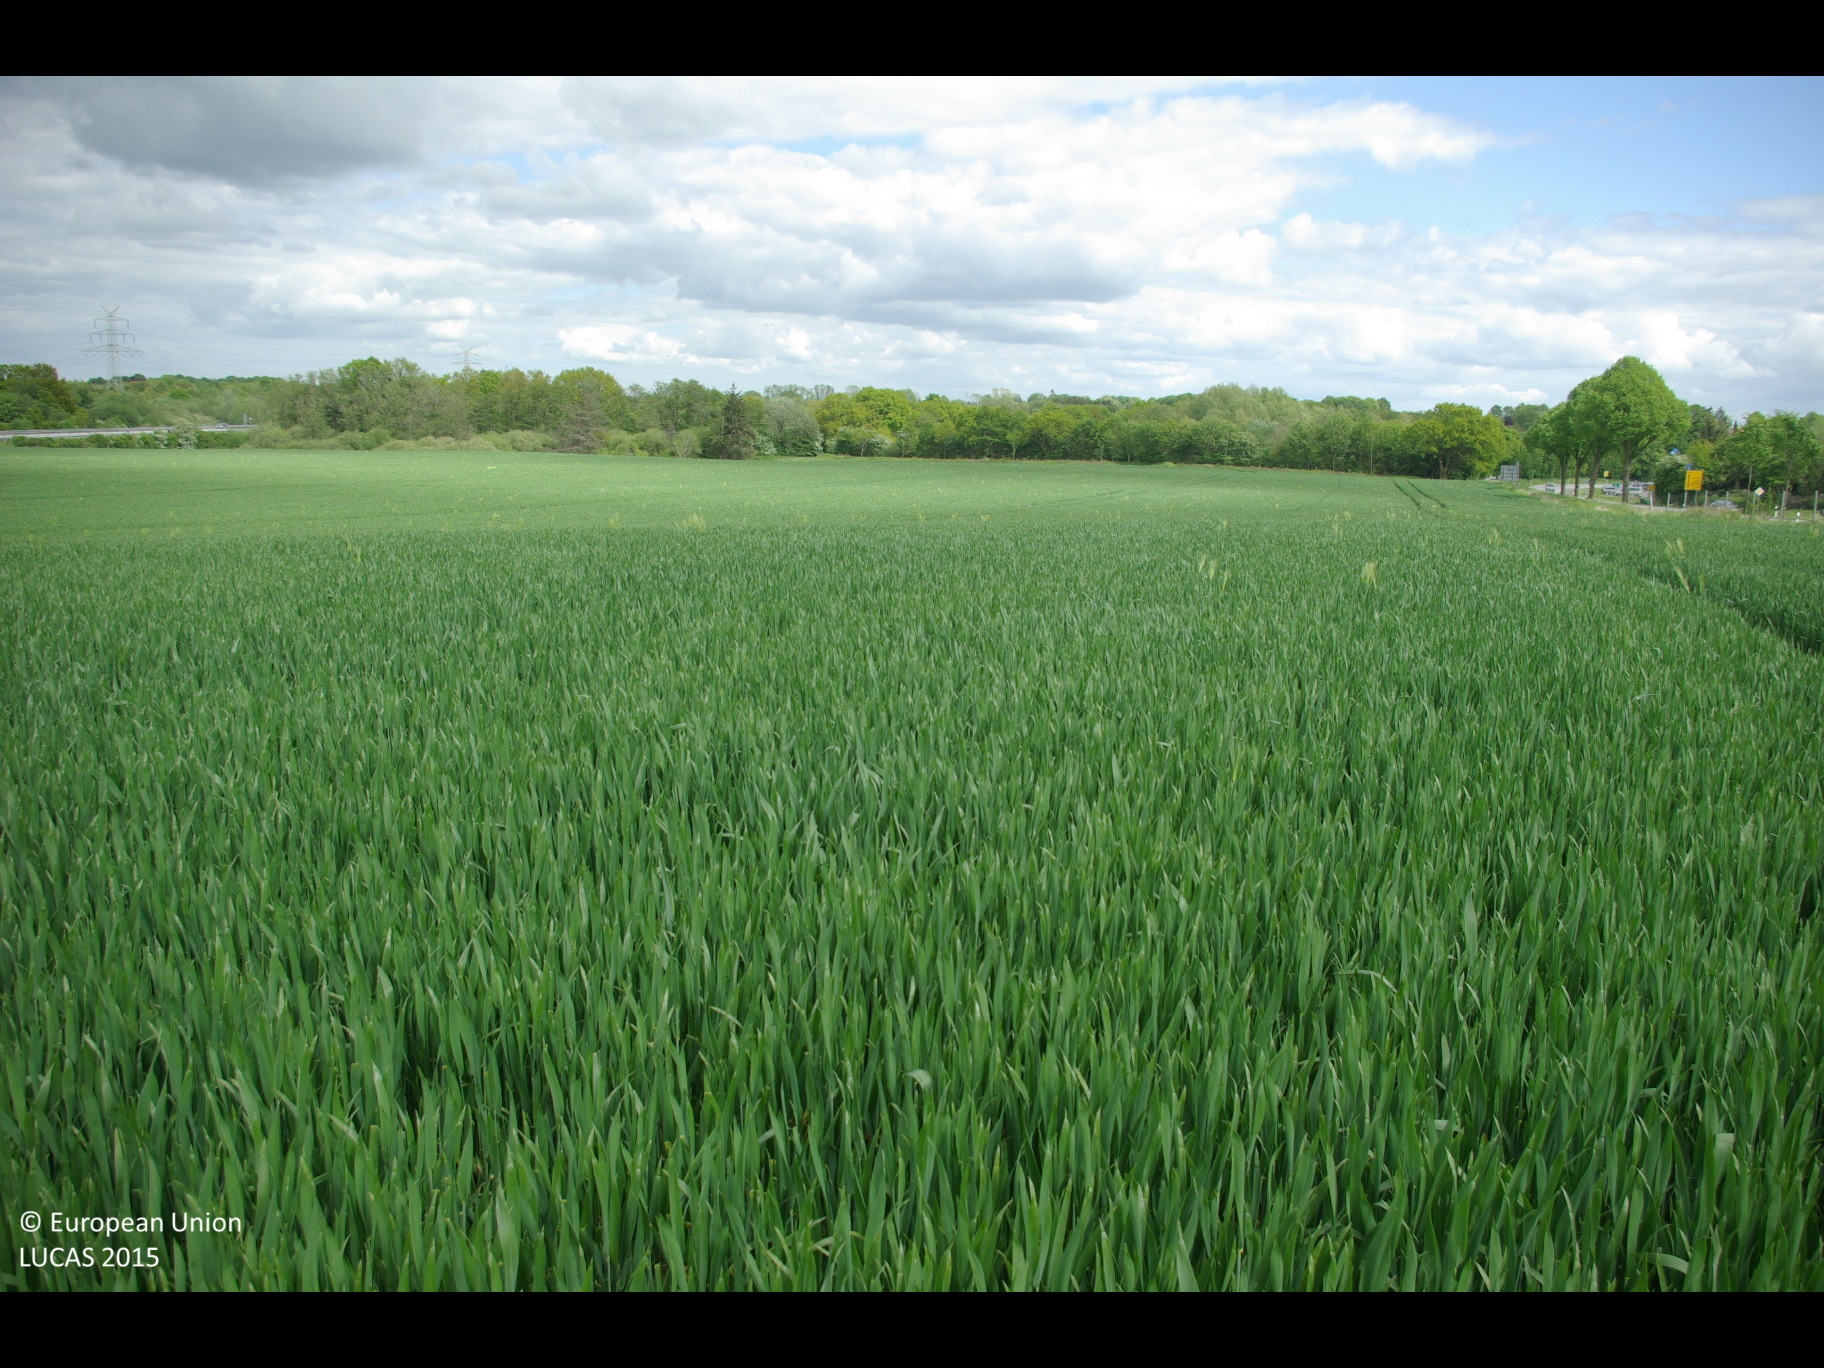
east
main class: Cropland
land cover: Common wheat
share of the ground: > 75 %
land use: Agriculture (excluding fallow land and kitchen gardens)
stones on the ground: < 10 %
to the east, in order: Common wheat
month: May
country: DE
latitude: 54.3185
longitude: 9.9539
